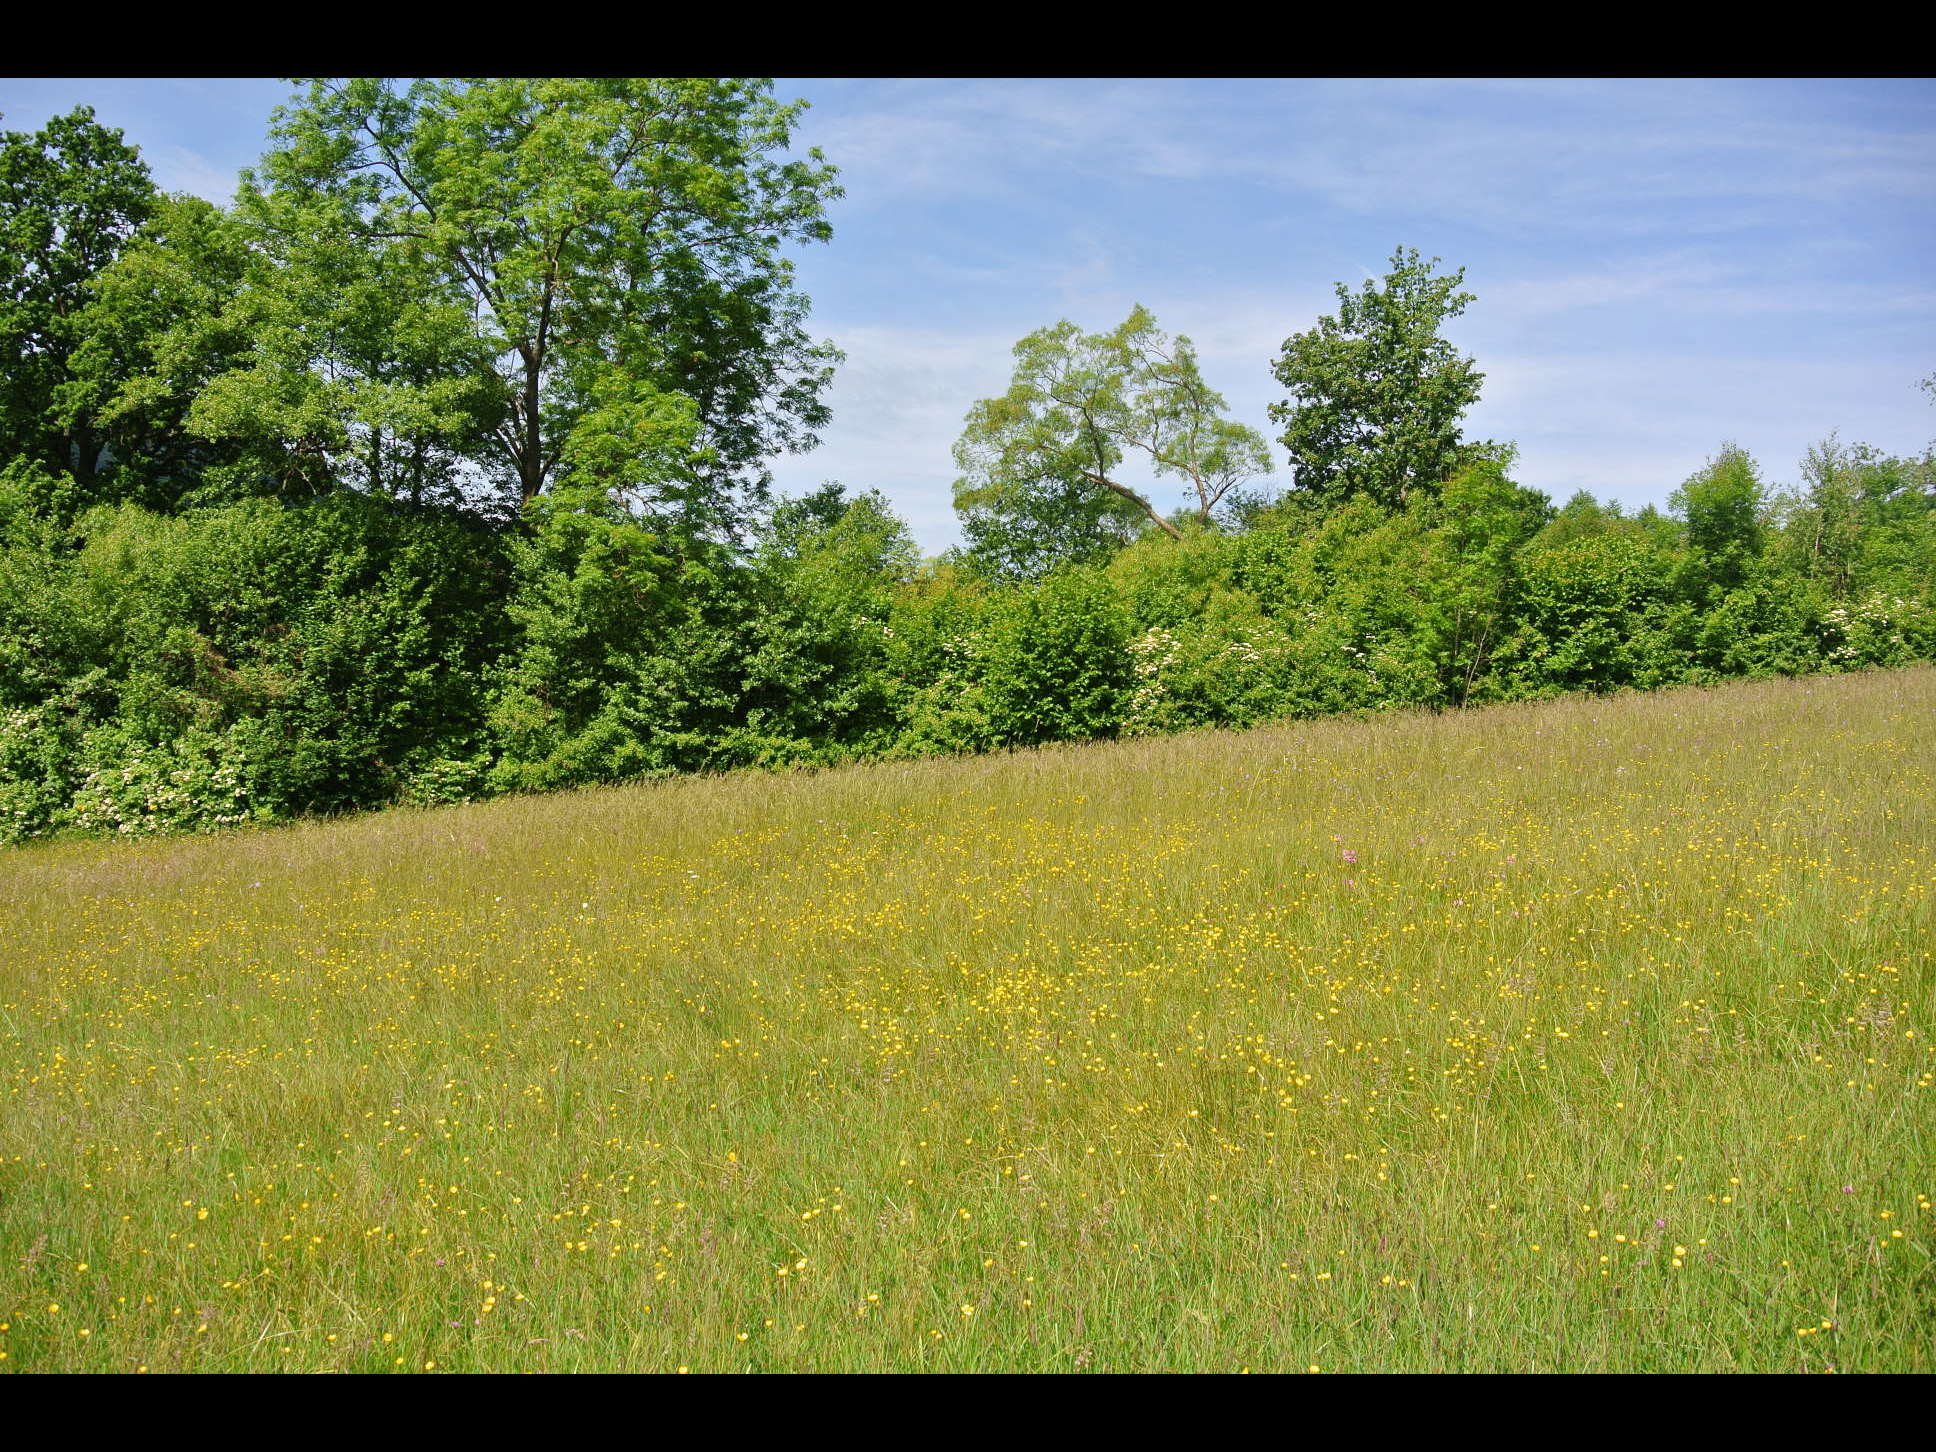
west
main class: Grassland
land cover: Grassland without tree/shrub cover
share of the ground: > 75 %
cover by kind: herbaceous plants 100 %
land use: Agriculture (excluding fallow land and kitchen gardens)
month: May
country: AT
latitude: 48.0357
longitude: 15.7833
